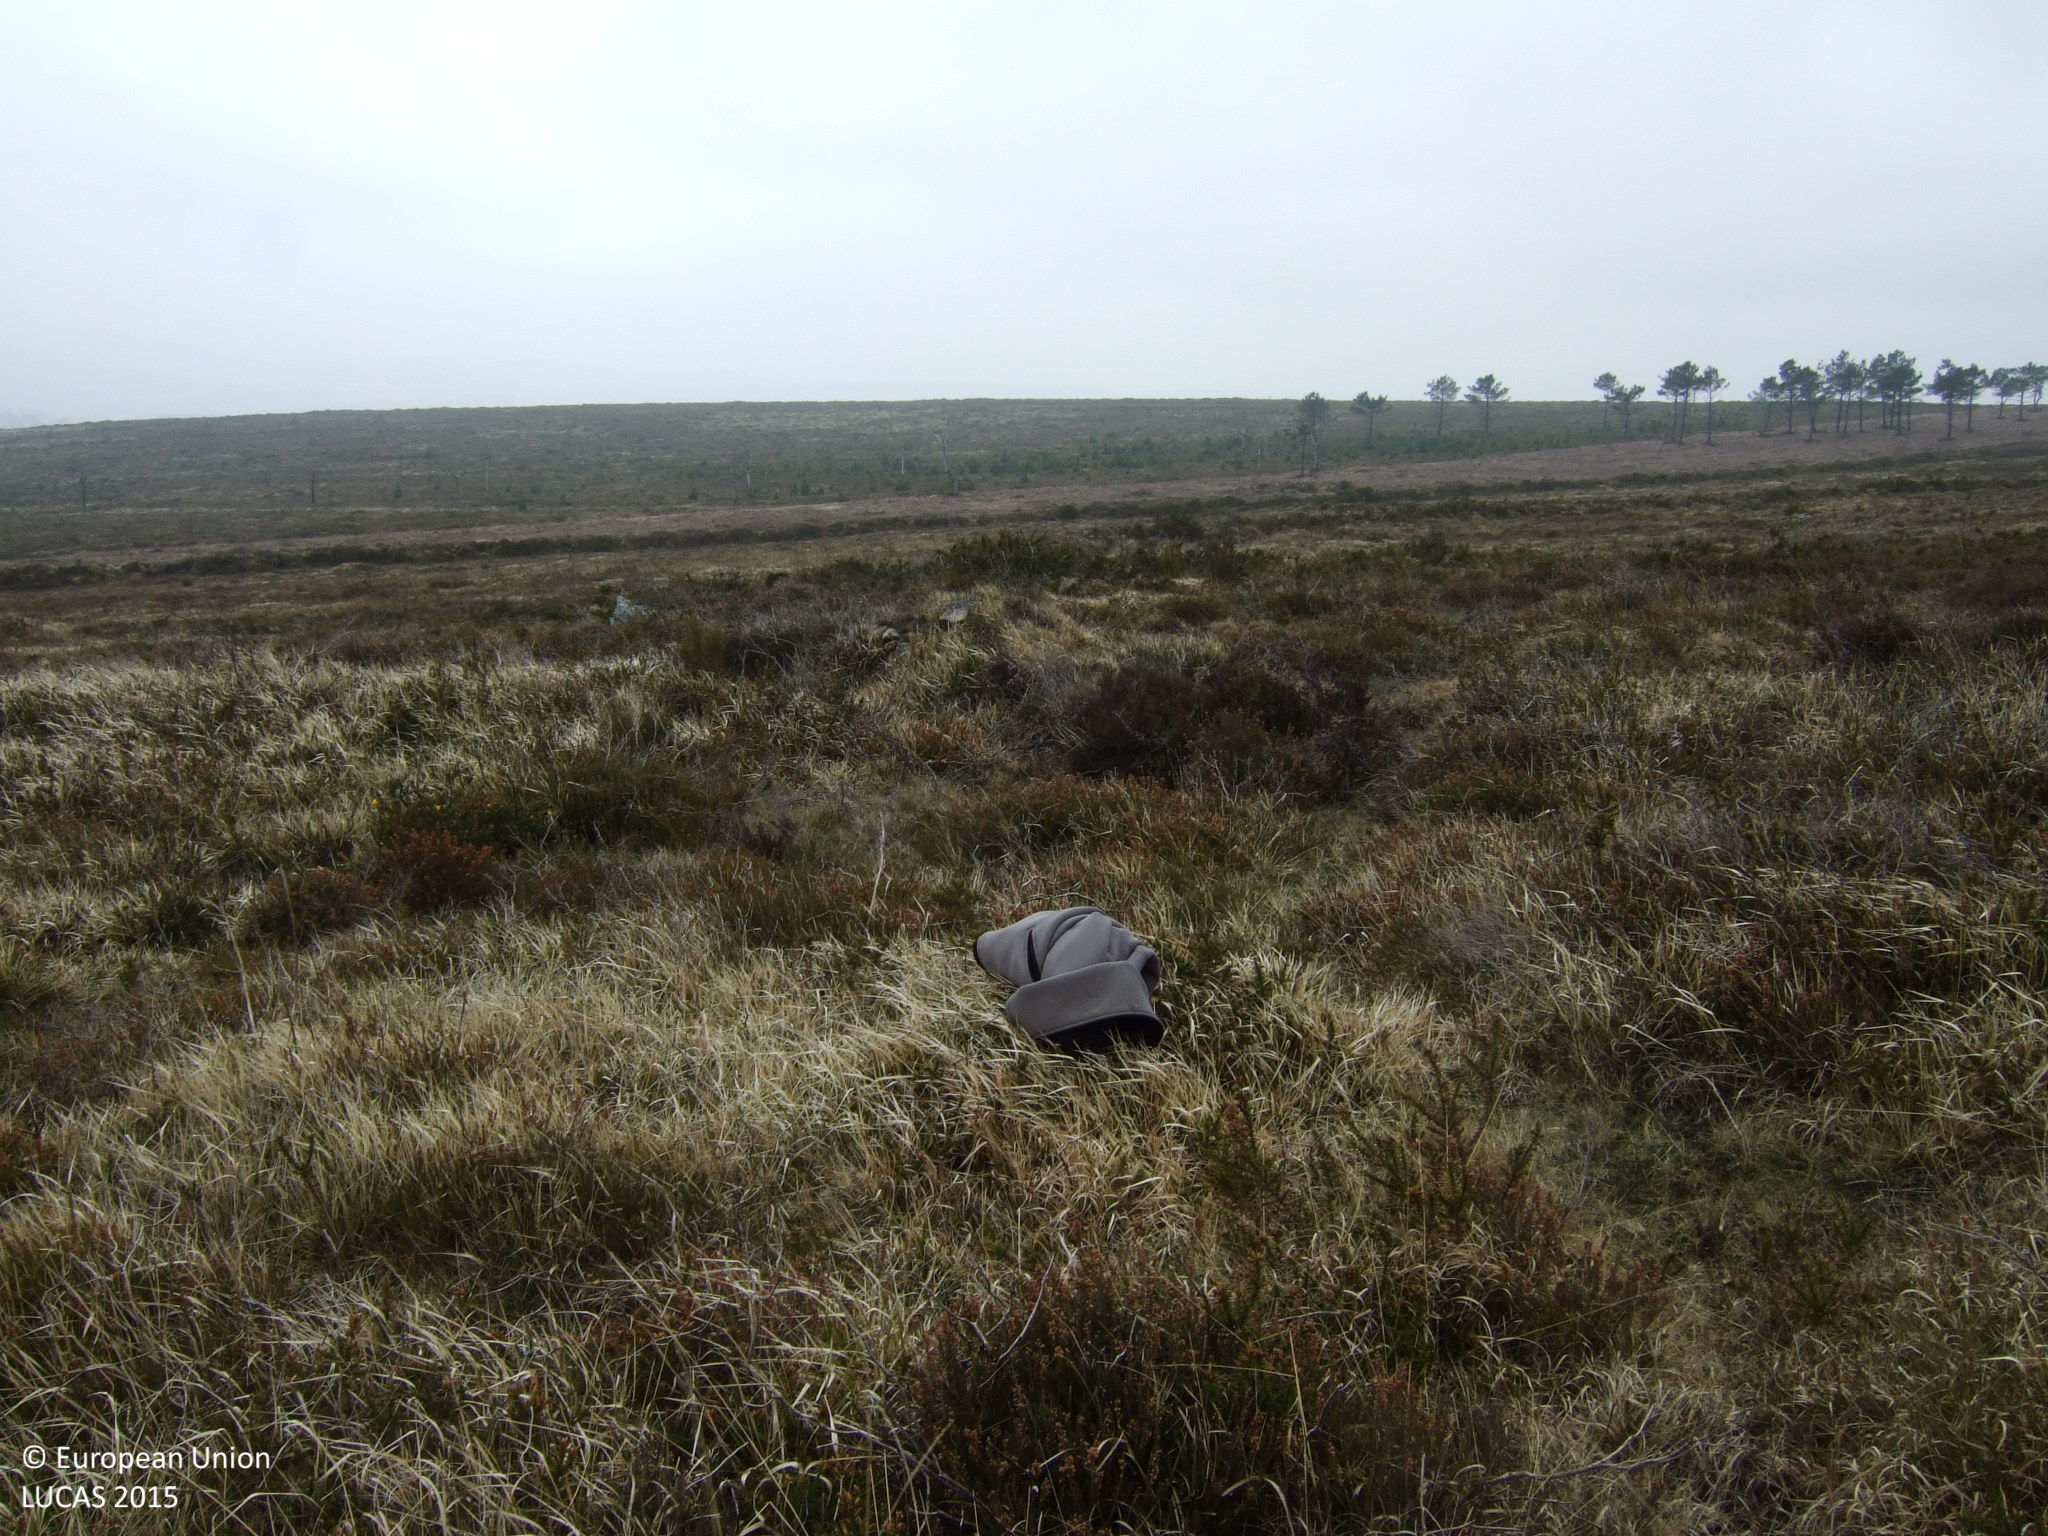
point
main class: Grassland
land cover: Grassland without tree/shrub cover
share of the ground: > 75 %
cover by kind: herbaceous plants 95 %, shrubs 5 %
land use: Agriculture (excluding fallow land and kitchen gardens)
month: March
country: ES
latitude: 42.9805
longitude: -7.9047
